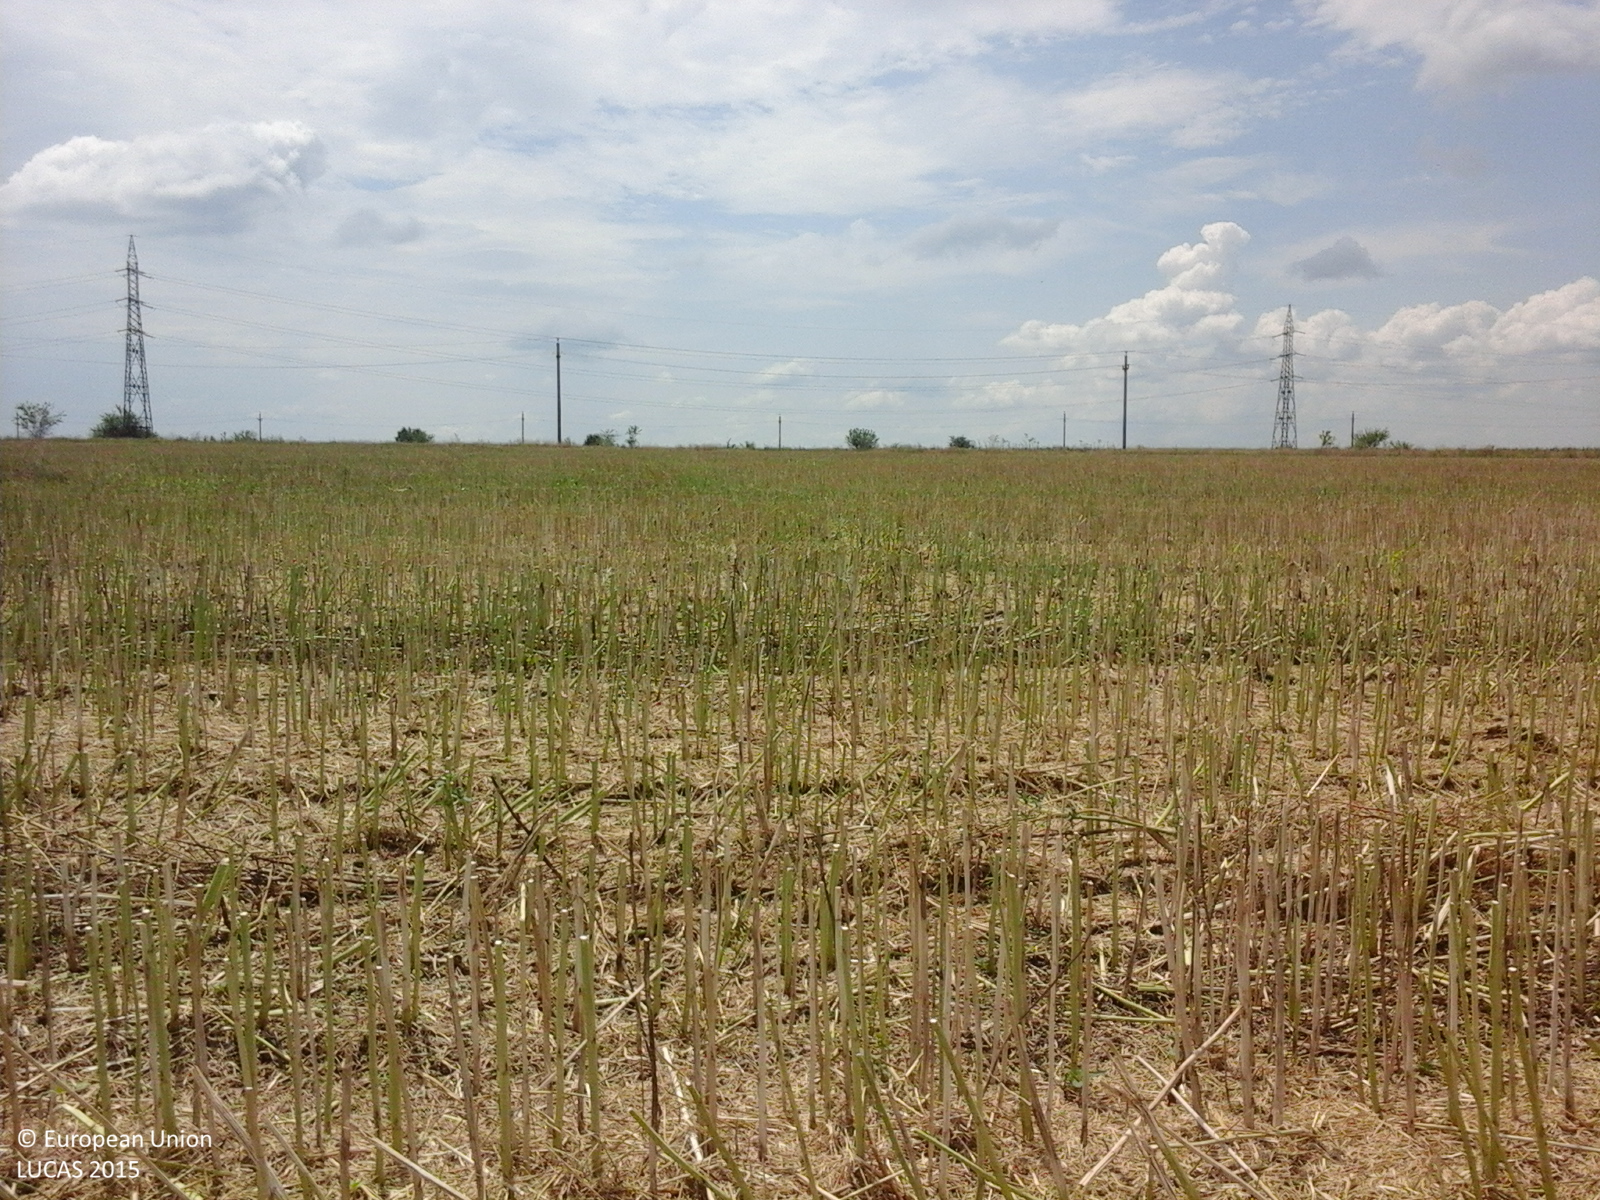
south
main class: Cropland
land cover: Rape and turnip rape
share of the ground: < 10 %
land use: Agriculture (excluding fallow land and kitchen gardens)
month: July
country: RO
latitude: 43.7916
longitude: 24.4420
